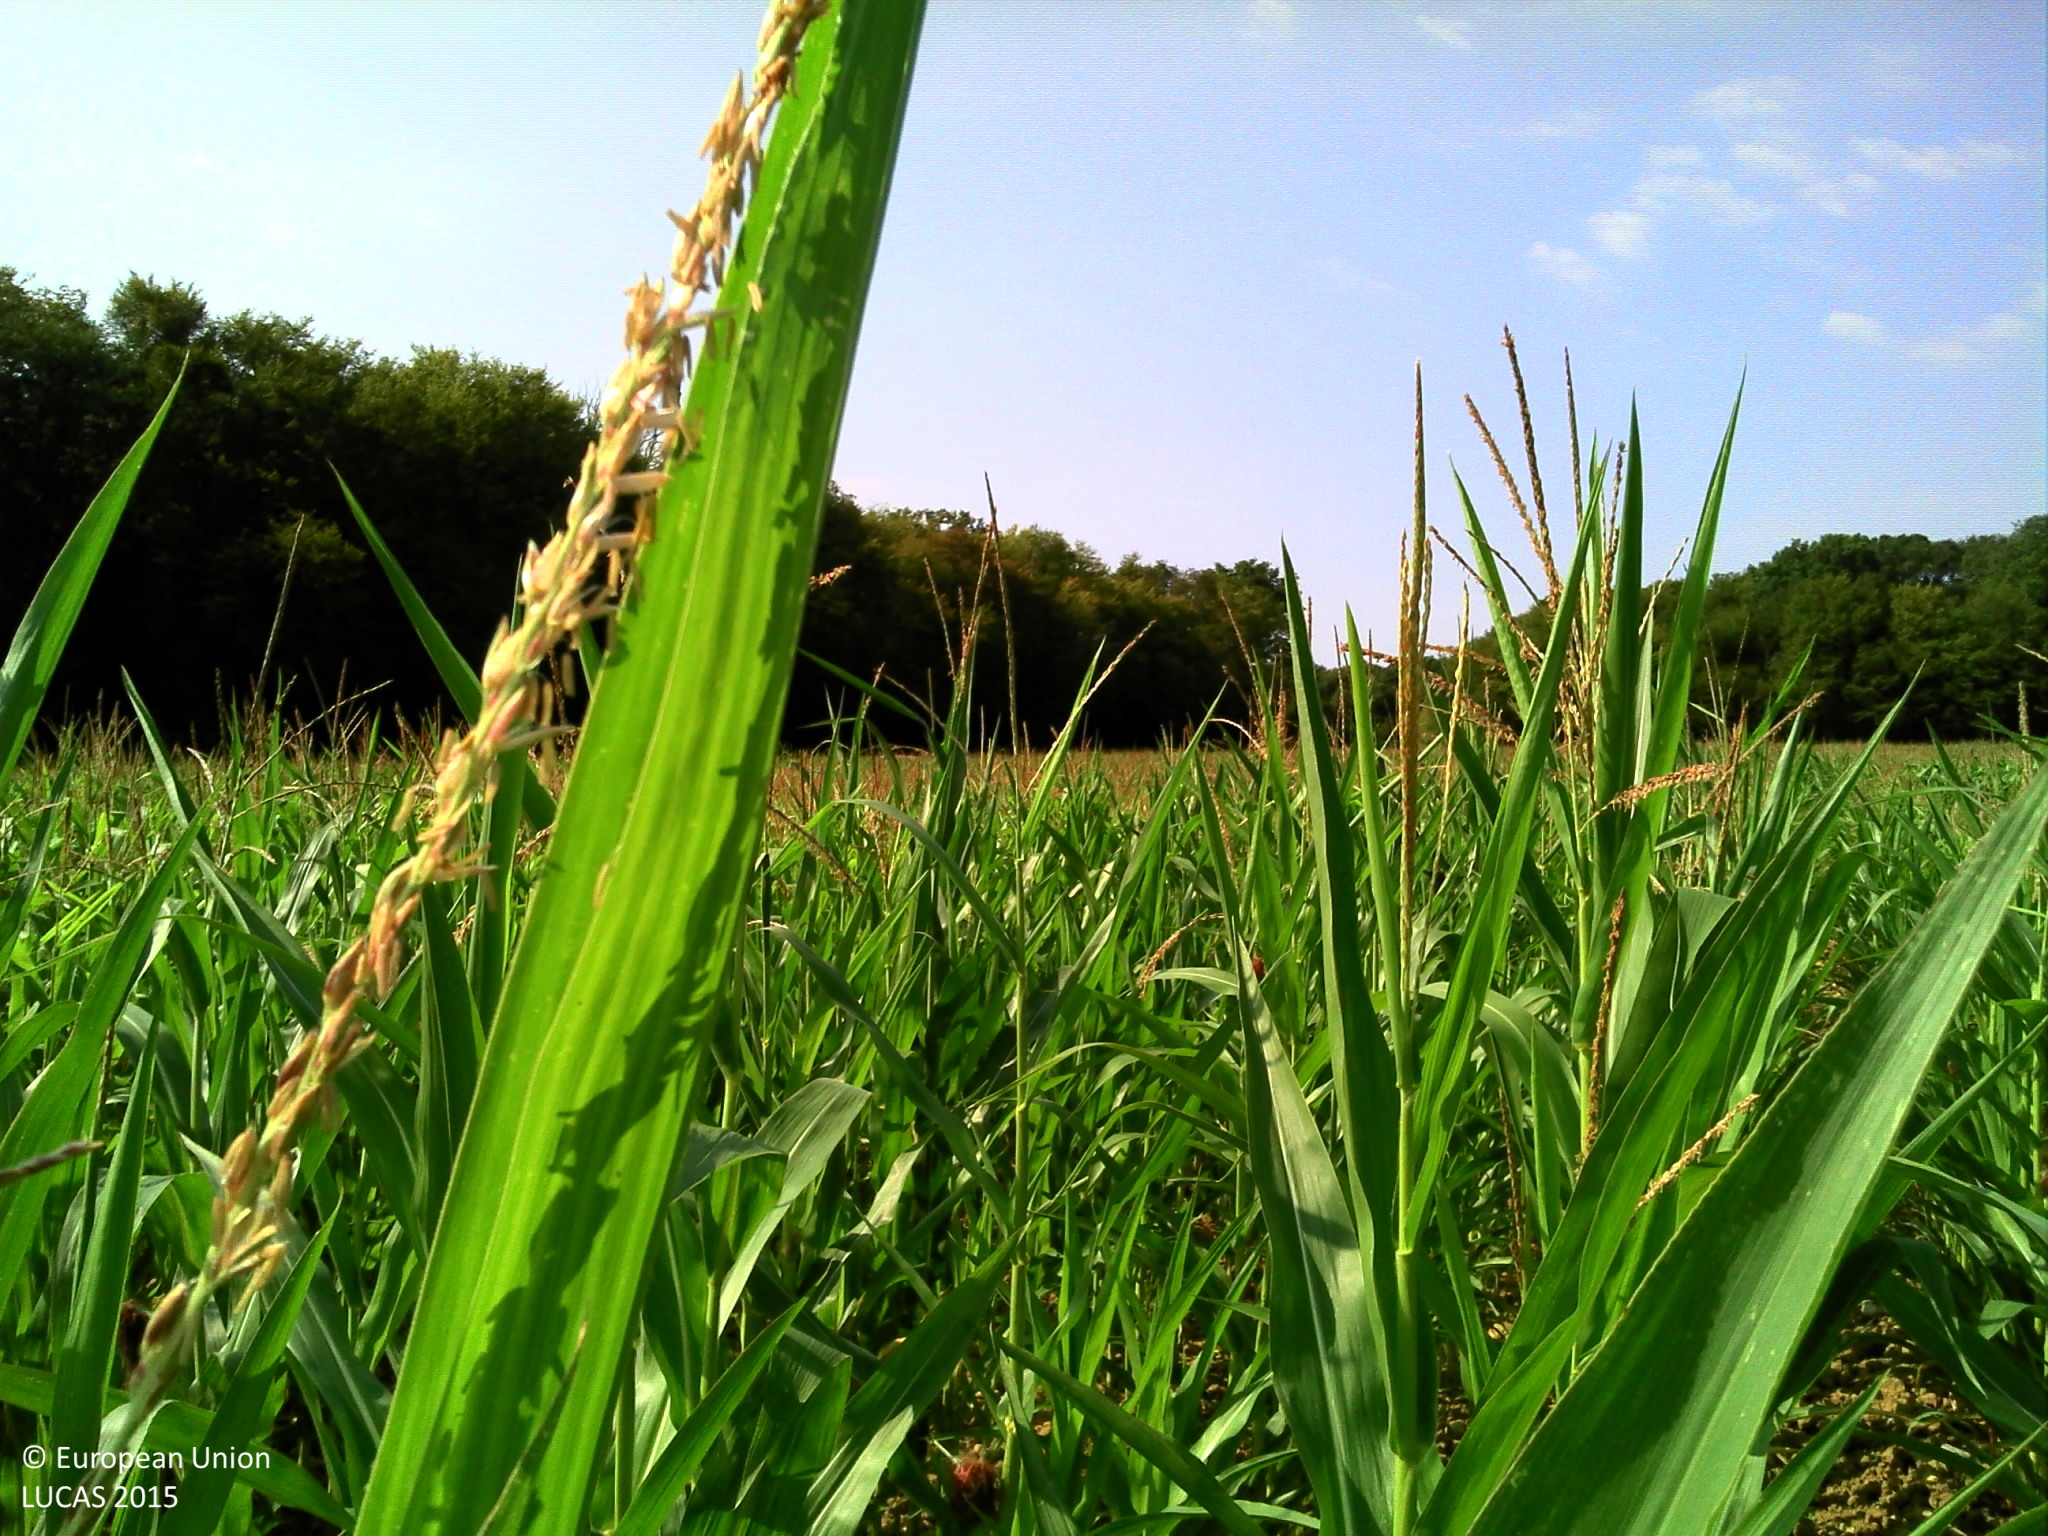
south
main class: Cropland
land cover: Maize
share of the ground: > 75 %
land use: Agriculture (excluding fallow land and kitchen gardens)
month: August
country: FR
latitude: 47.7039
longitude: 3.1578
